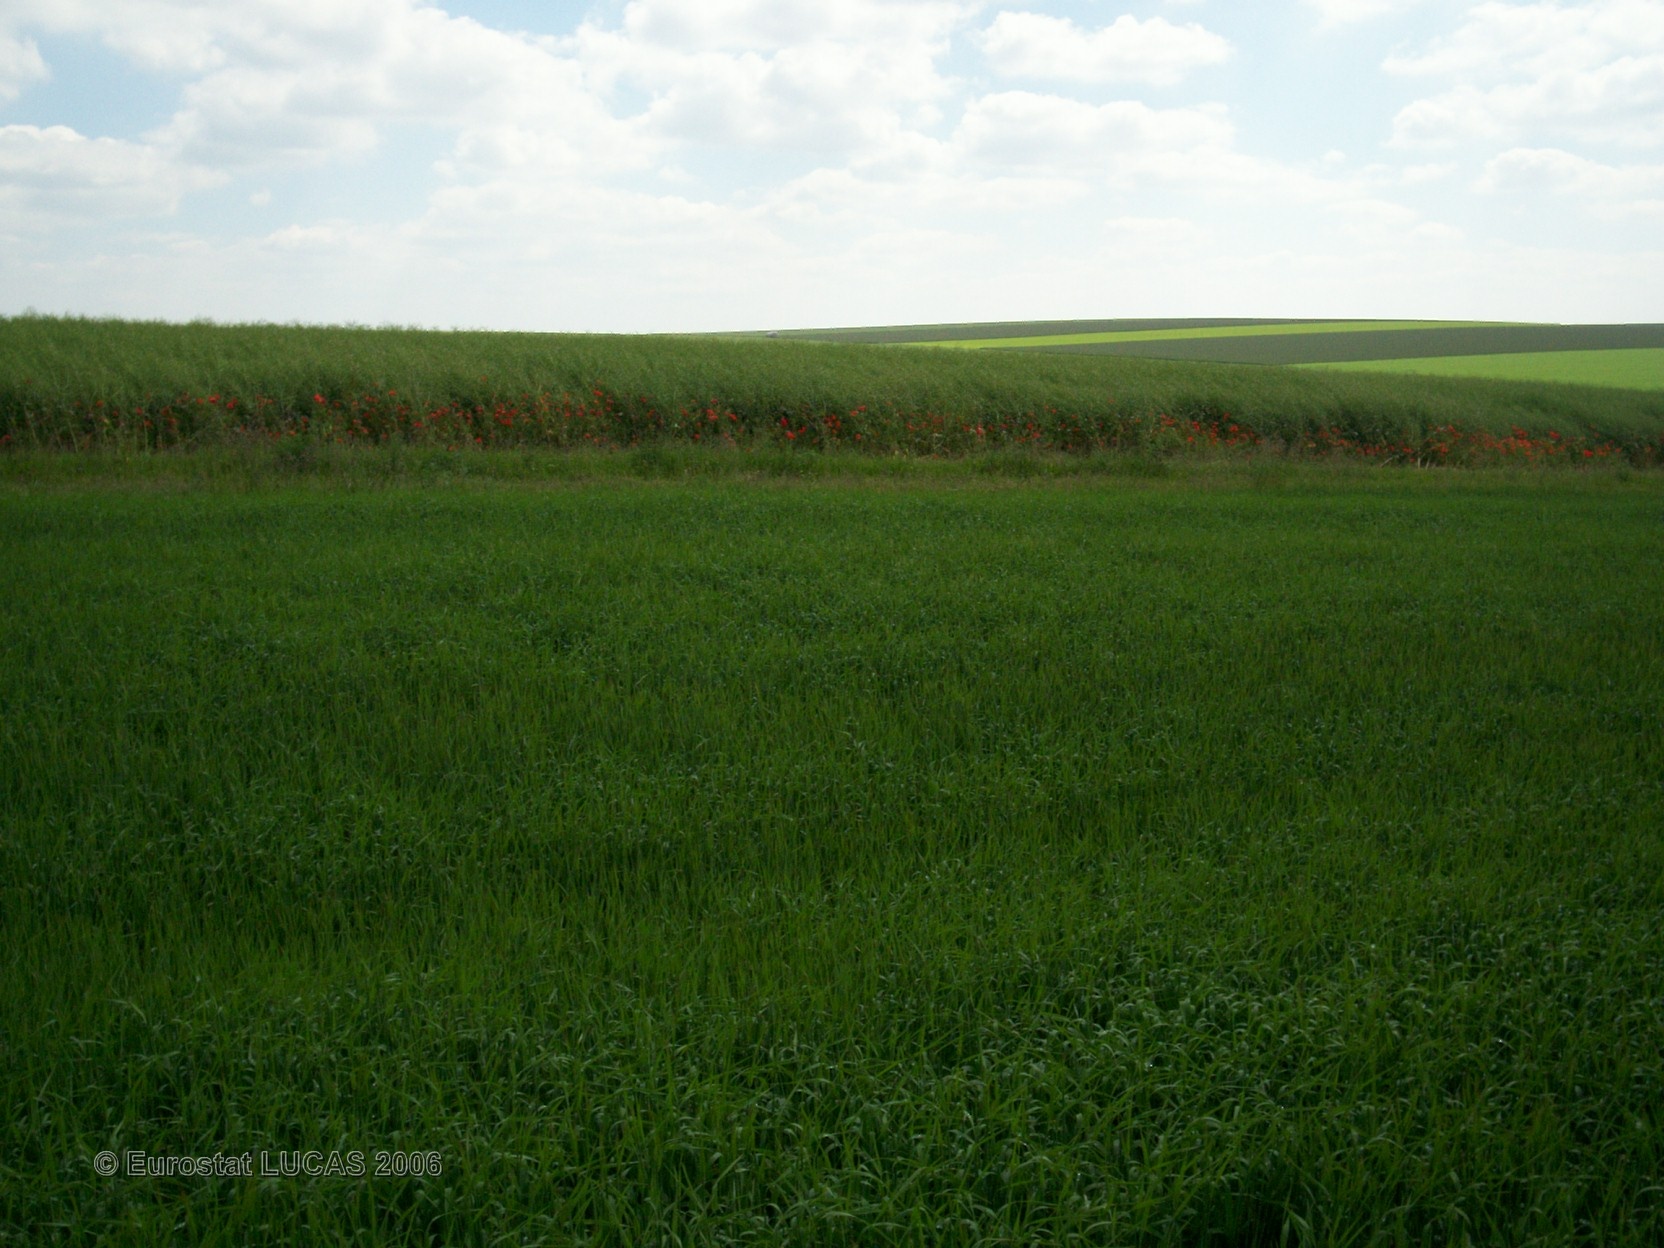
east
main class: Cropland
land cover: Barley
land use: Agriculture (excluding fallow land and kitchen gardens)
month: June
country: FR
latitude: 48.7695
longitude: 4.4591
